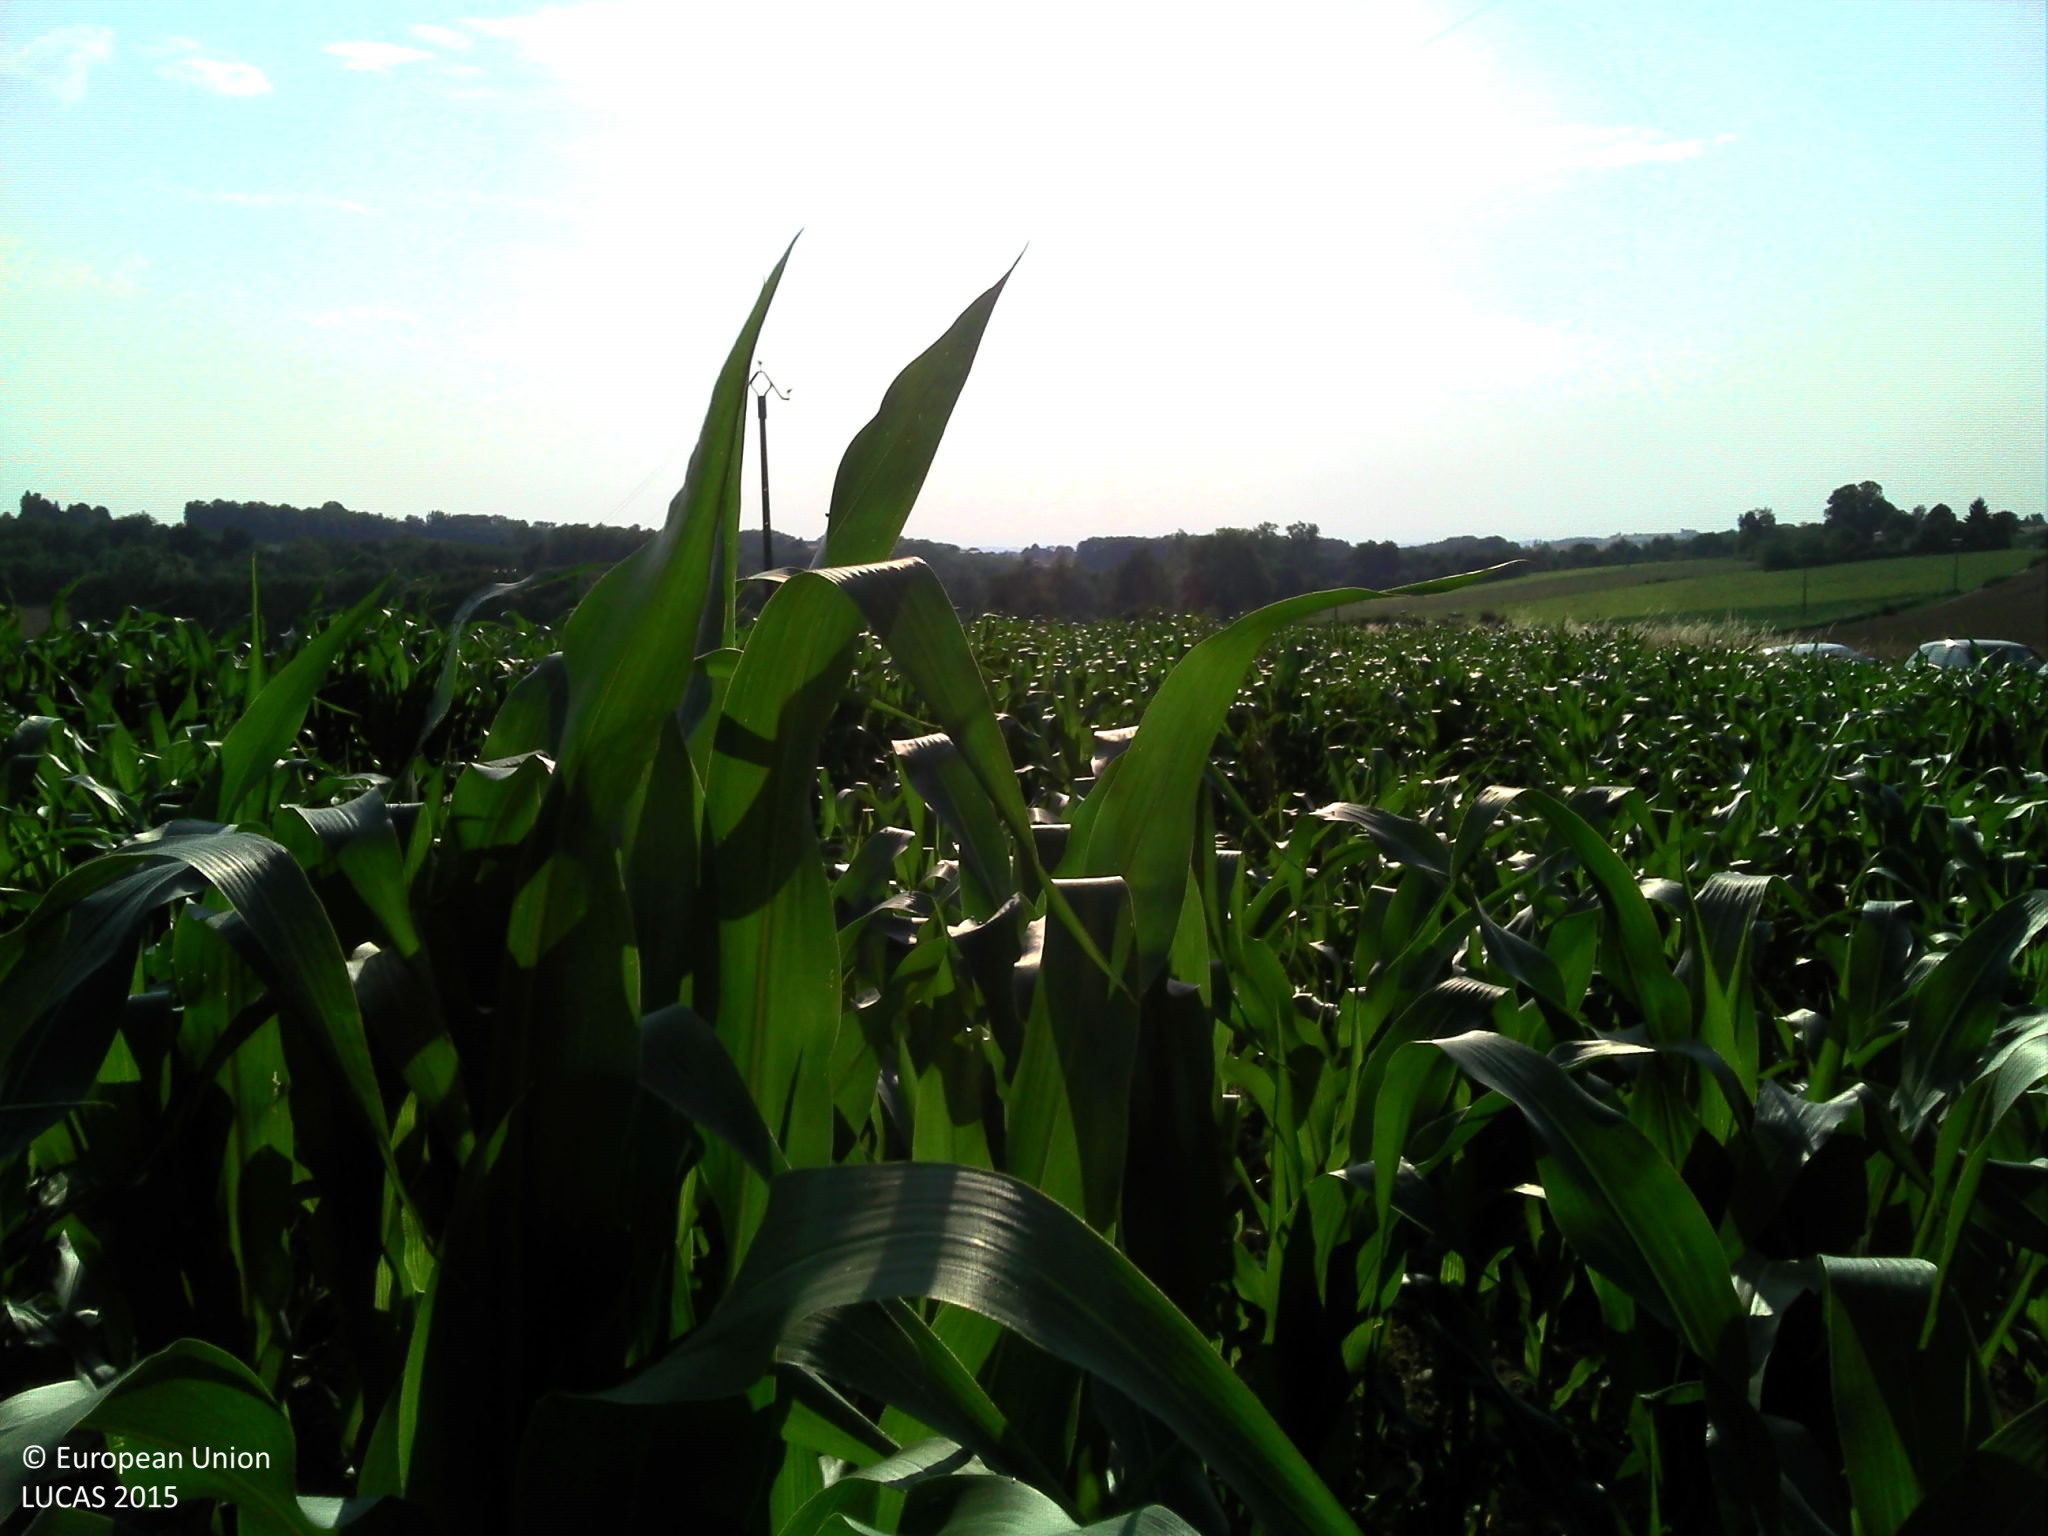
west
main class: Grassland
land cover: Grassland with sparse tree/shrub cover
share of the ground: > 75 %
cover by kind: herbaceous plants 70 %, consolidated bare surface 15 %, shrubs 10 %, broadleaved forest trees 5 %
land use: Residential
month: July
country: FR
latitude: 45.6005
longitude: 5.3505
